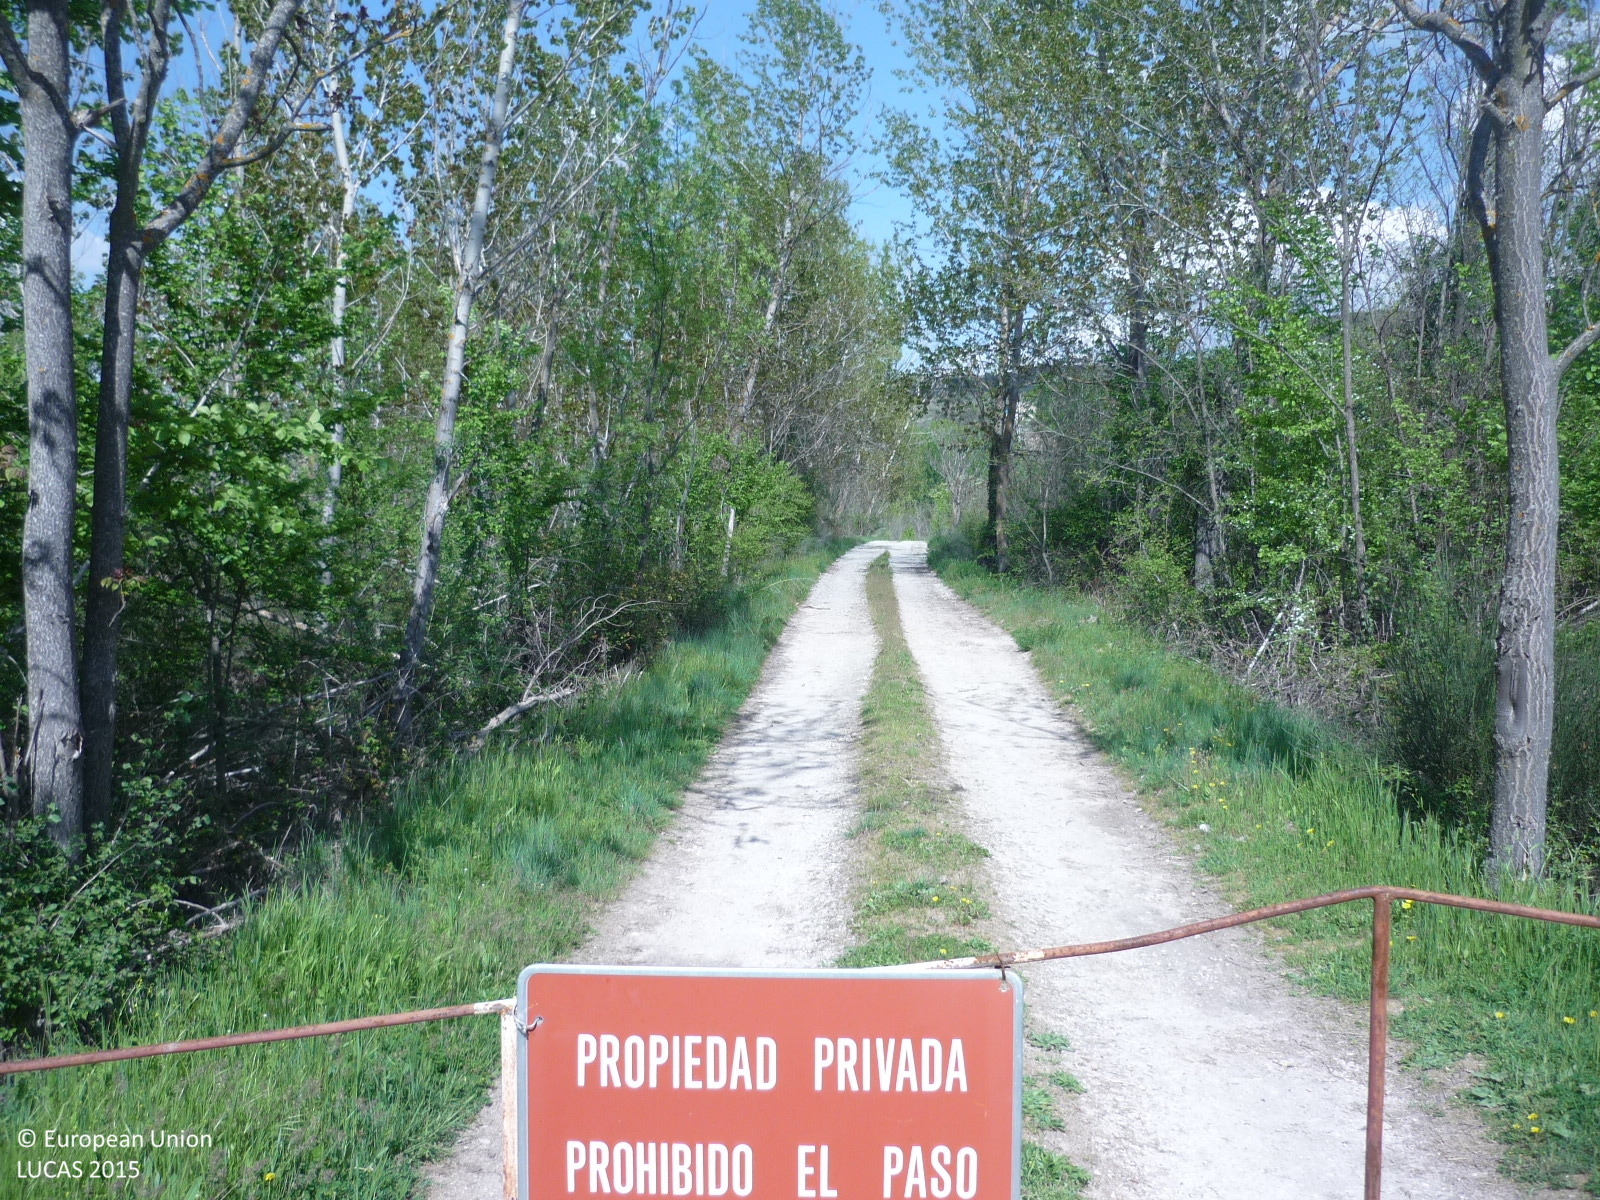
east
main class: Cropland
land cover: Permanent crops (only in case pi)
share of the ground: 50 - 75 %
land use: Agriculture (excluding fallow land and kitchen gardens)
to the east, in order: Permanent crops (only in case pi); Shrubland without tree cover; Rivers and streams; Shrubland without tree cover
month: April
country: ES
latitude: 40.7923
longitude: -3.5148
